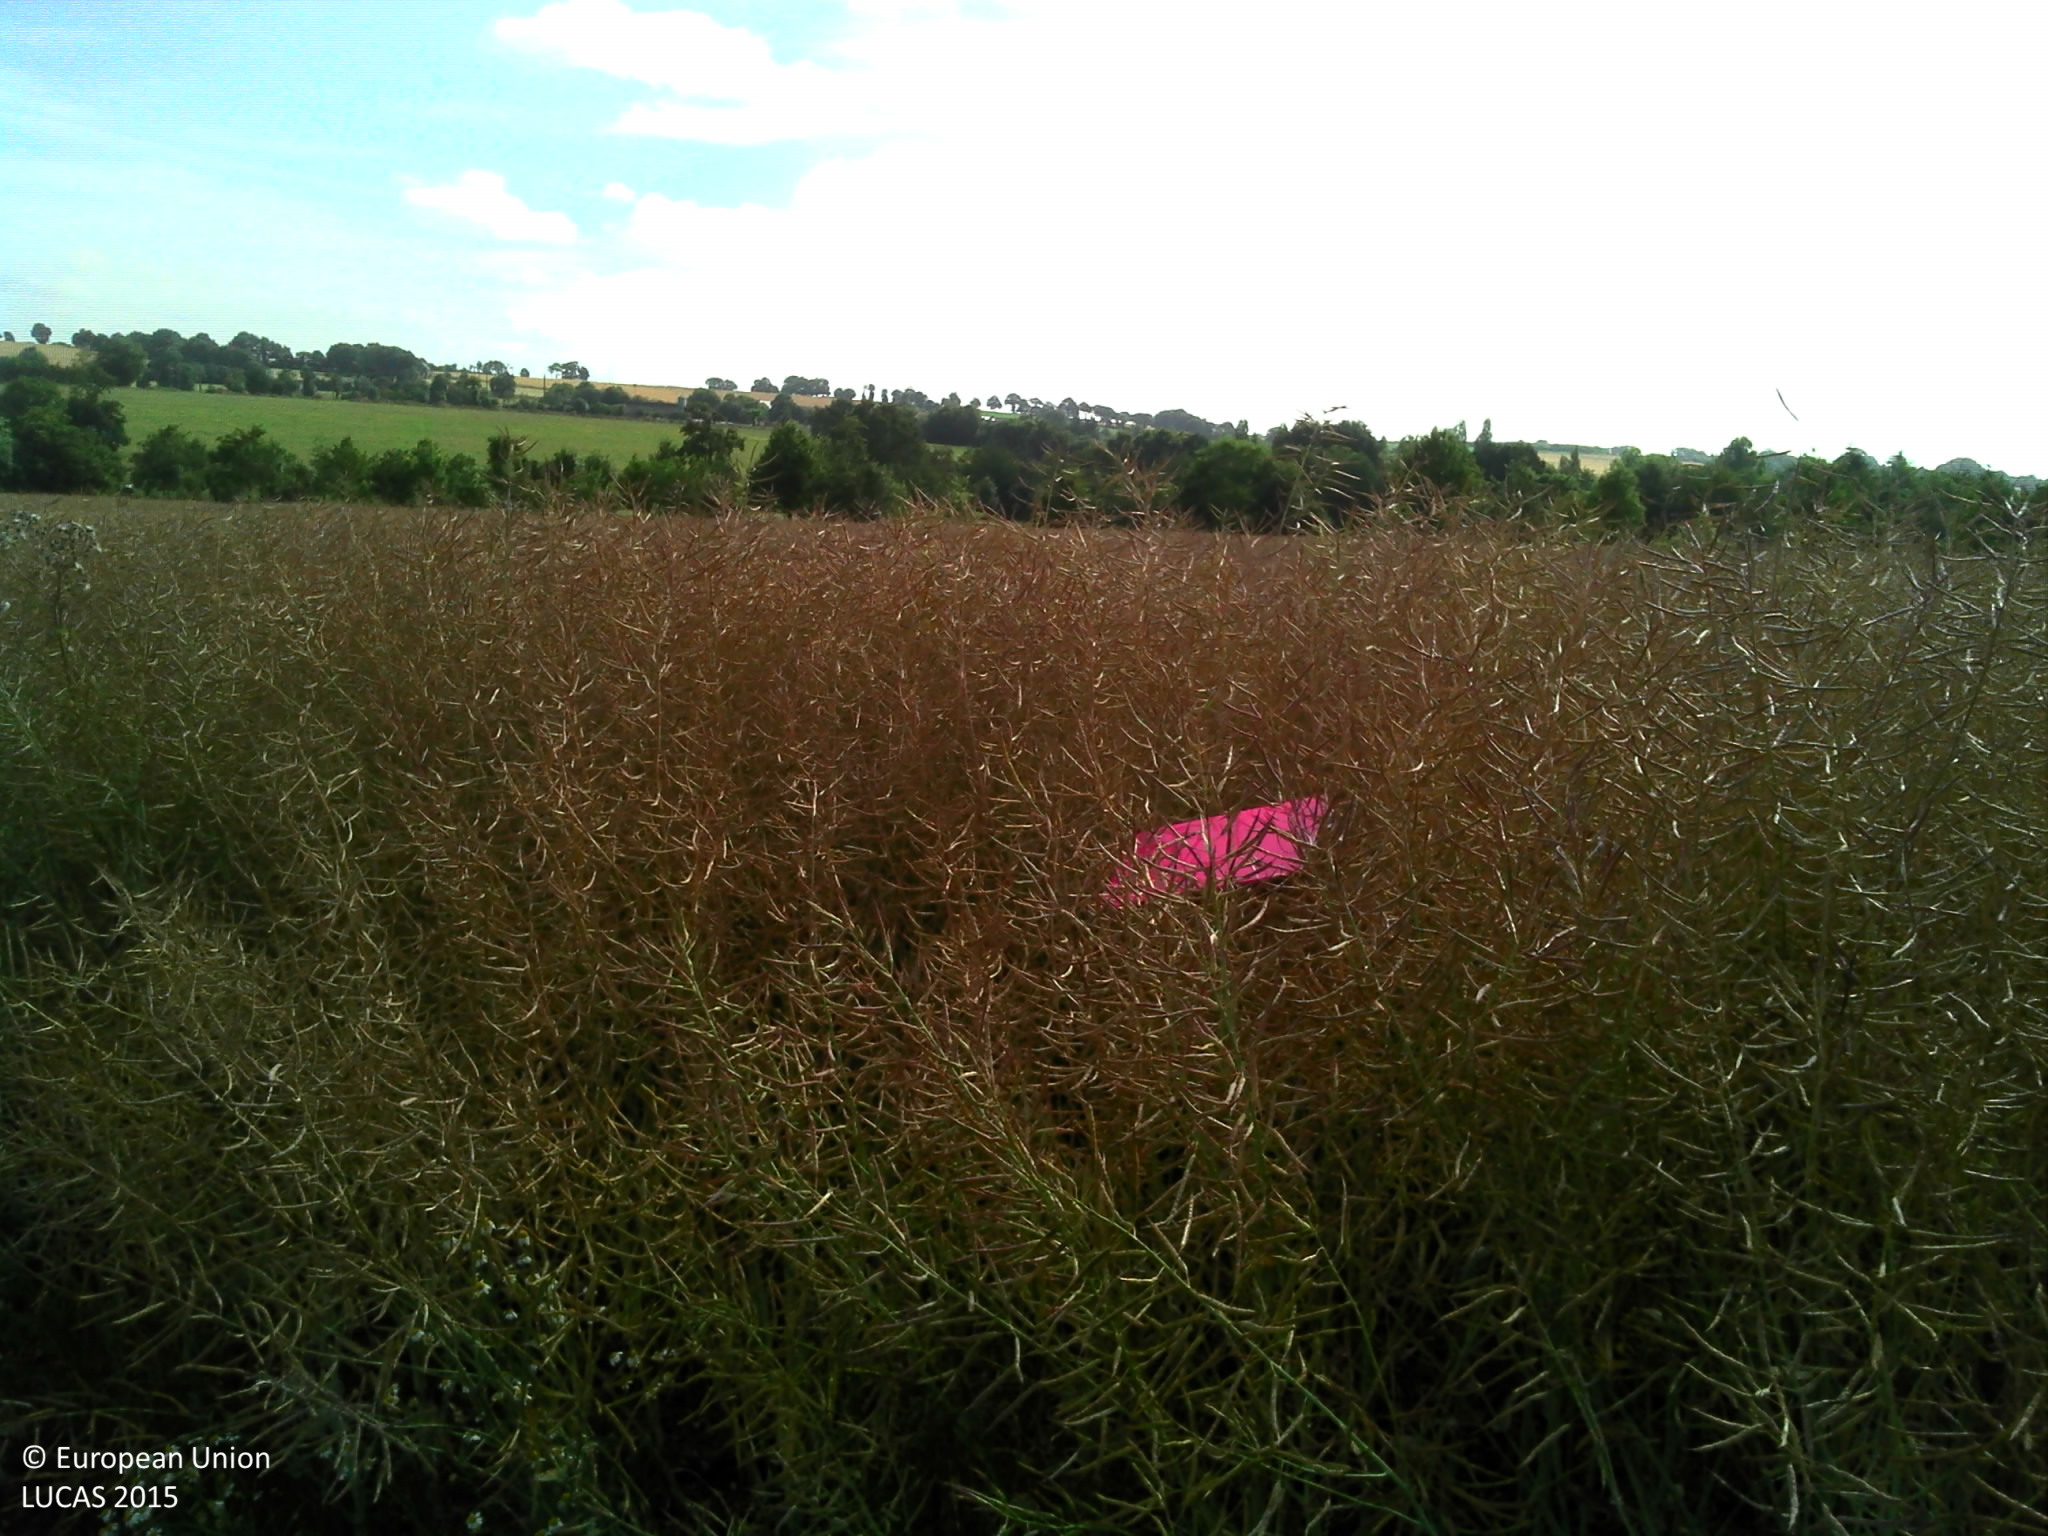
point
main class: Cropland
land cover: Rape and turnip rape
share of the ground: > 75 %
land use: Agriculture (excluding fallow land and kitchen gardens)
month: June
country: FR
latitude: 47.8830
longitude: -1.5862
